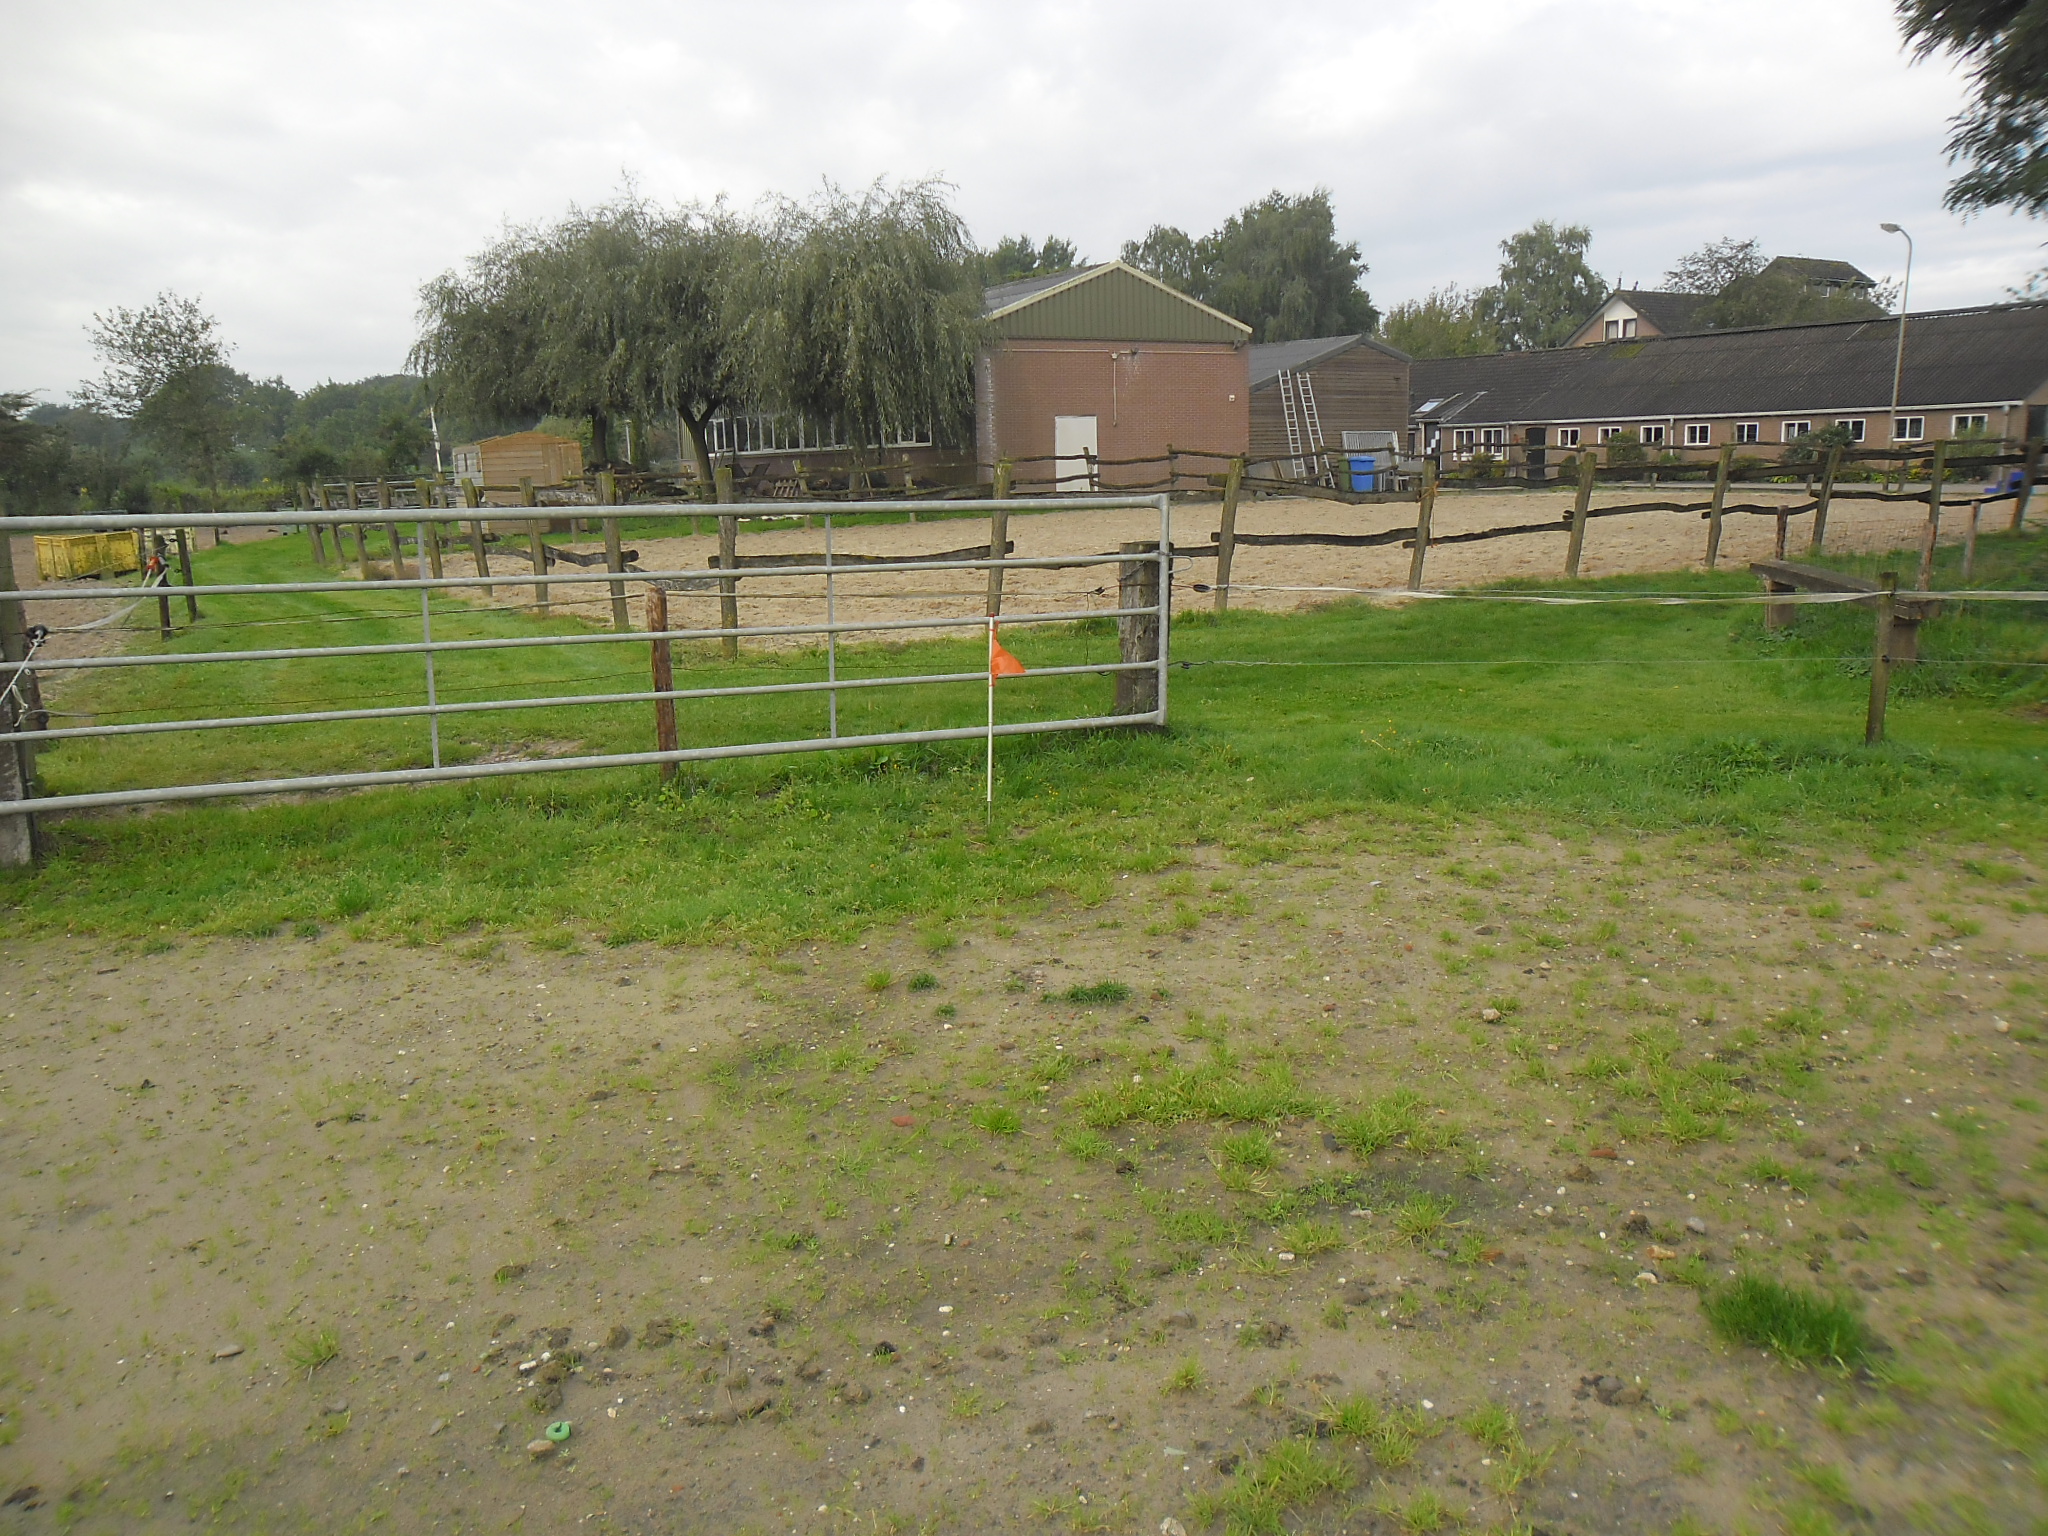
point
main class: Grassland
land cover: Grassland without tree/shrub cover
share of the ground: > 75 %
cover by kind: herbaceous plants 100 %
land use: Agriculture (excluding fallow land and kitchen gardens)
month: September
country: NL
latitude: 52.1128
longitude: 5.5153
